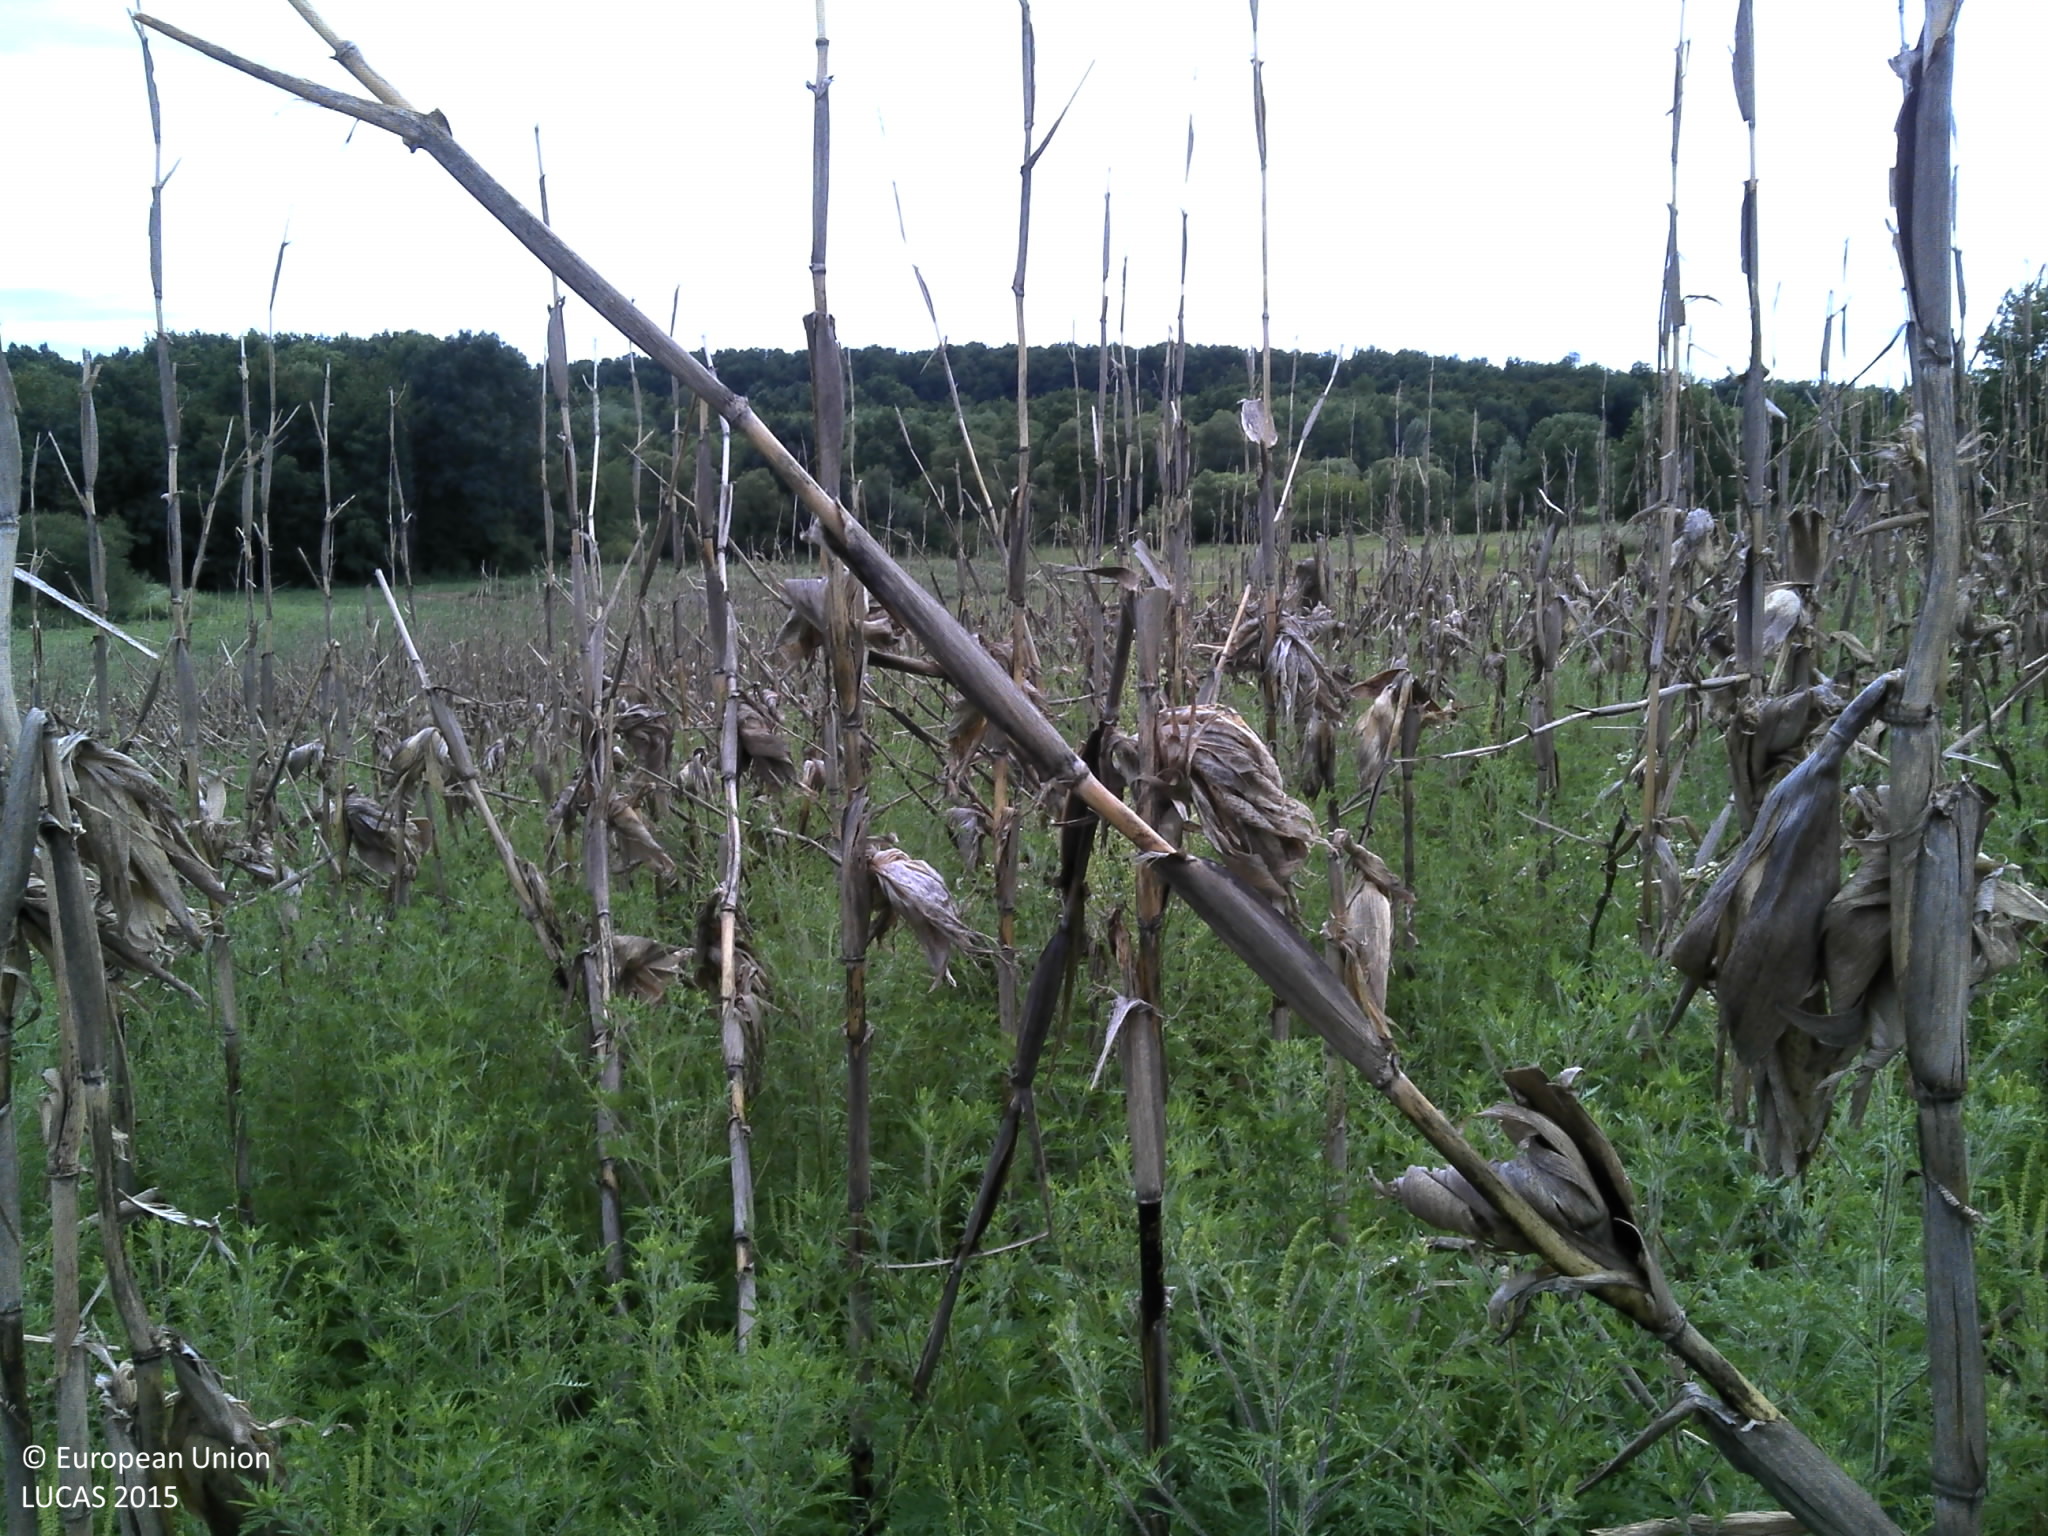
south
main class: Grassland
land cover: Spontaneously vegetated surfaces
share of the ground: > 75 %
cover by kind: herbaceous plants 100 %
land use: Semi-natural and natural areas not in use
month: July
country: HR
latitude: 45.6034
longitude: 16.6274
